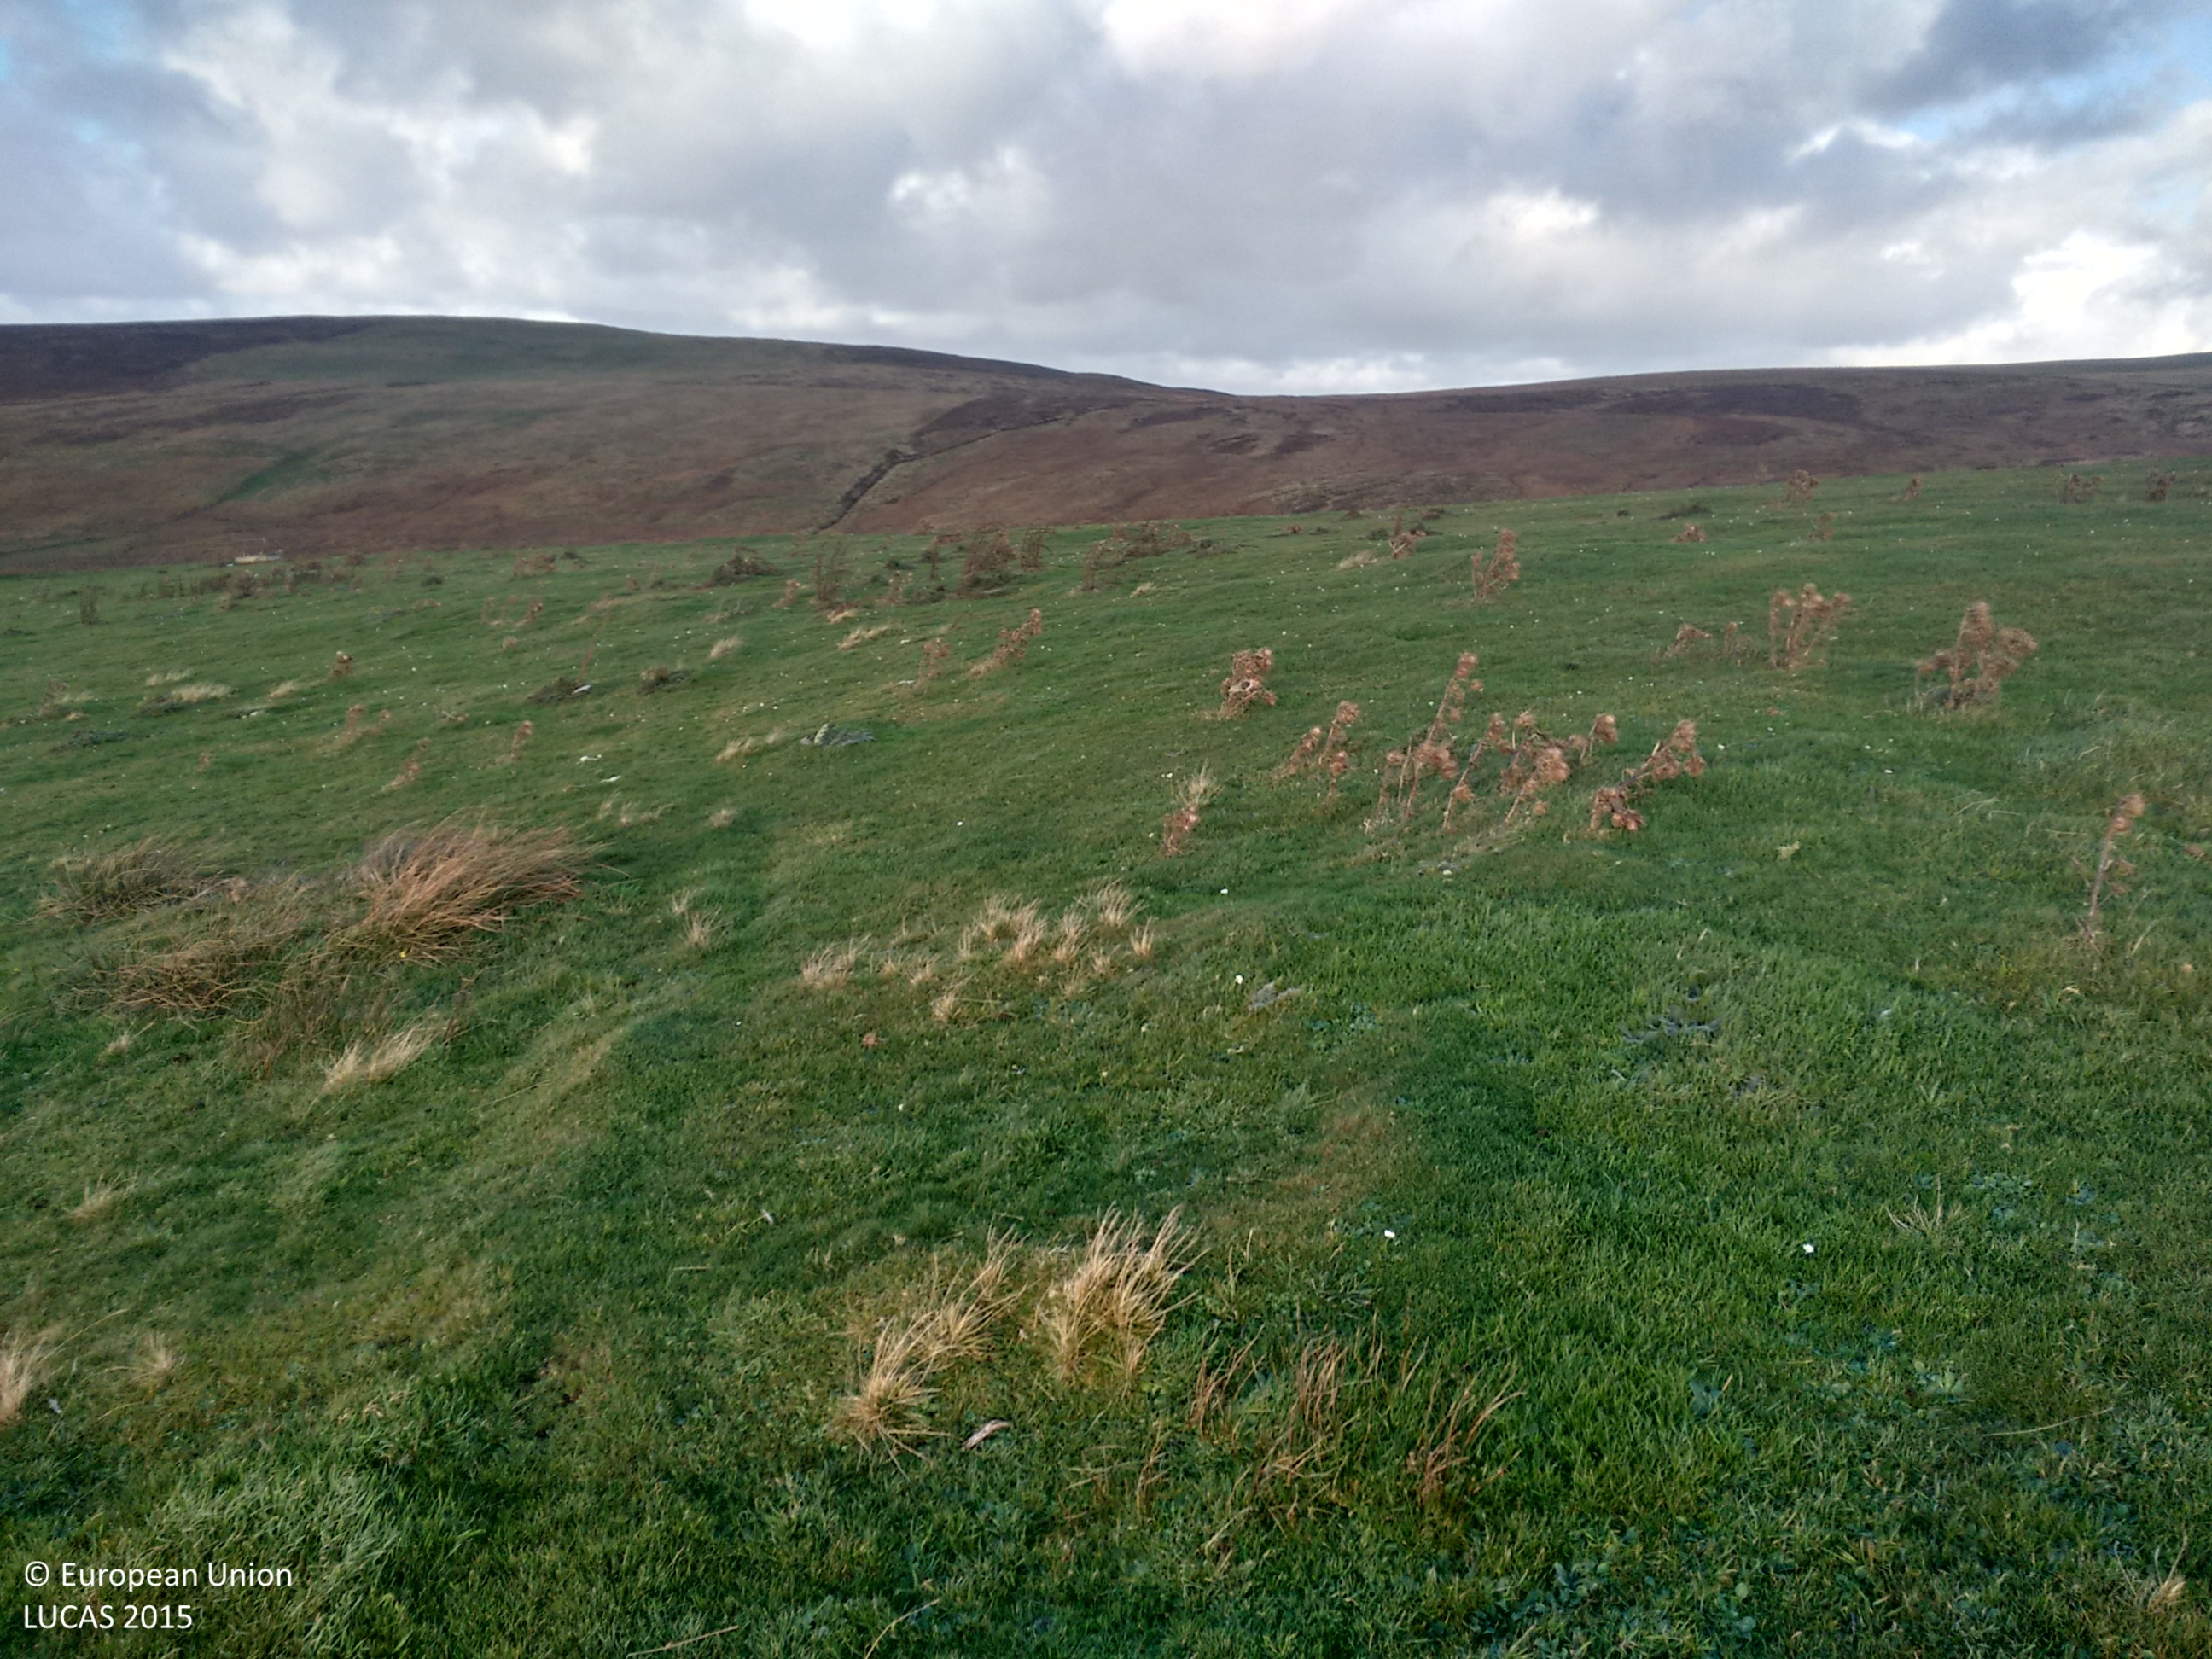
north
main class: Grassland
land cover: Grassland without tree/shrub cover
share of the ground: > 75 %
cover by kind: herbaceous plants 100 %
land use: Agriculture (excluding fallow land and kitchen gardens)
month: November
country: GB
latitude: 58.9946
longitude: -3.3382
